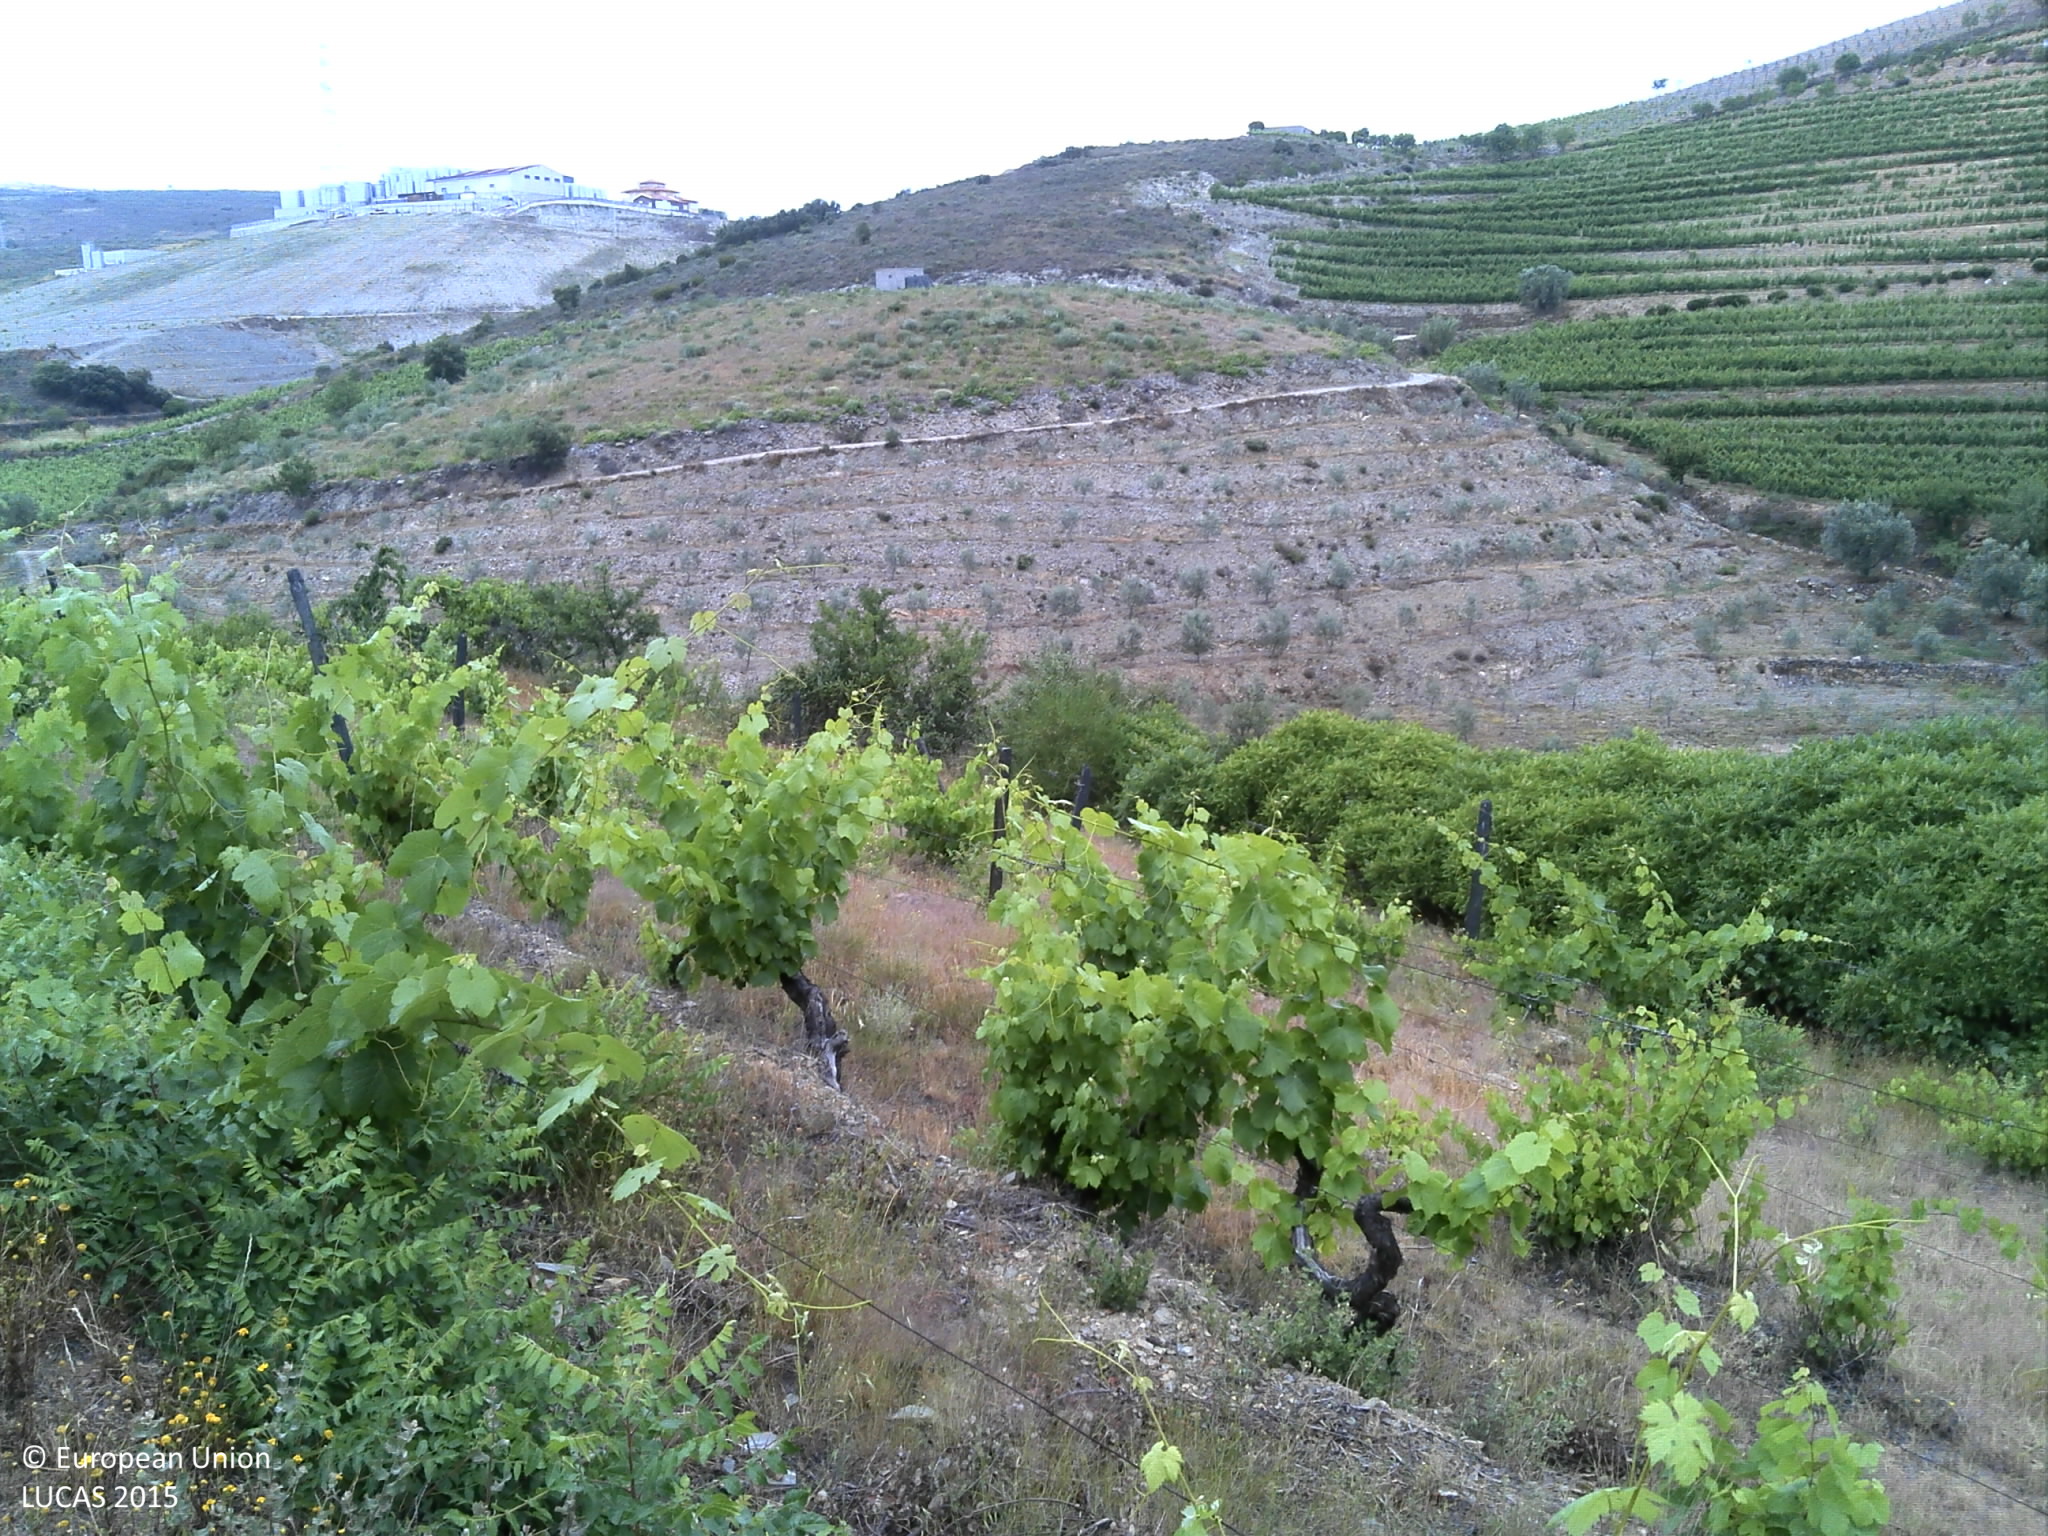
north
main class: Cropland
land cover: Vineyards
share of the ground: < 10 %
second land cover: Spontaneously vegetated surfaces
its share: 10 - 25 %
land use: Agriculture (excluding fallow land and kitchen gardens)
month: June
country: PT
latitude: 41.1469
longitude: -7.4324
